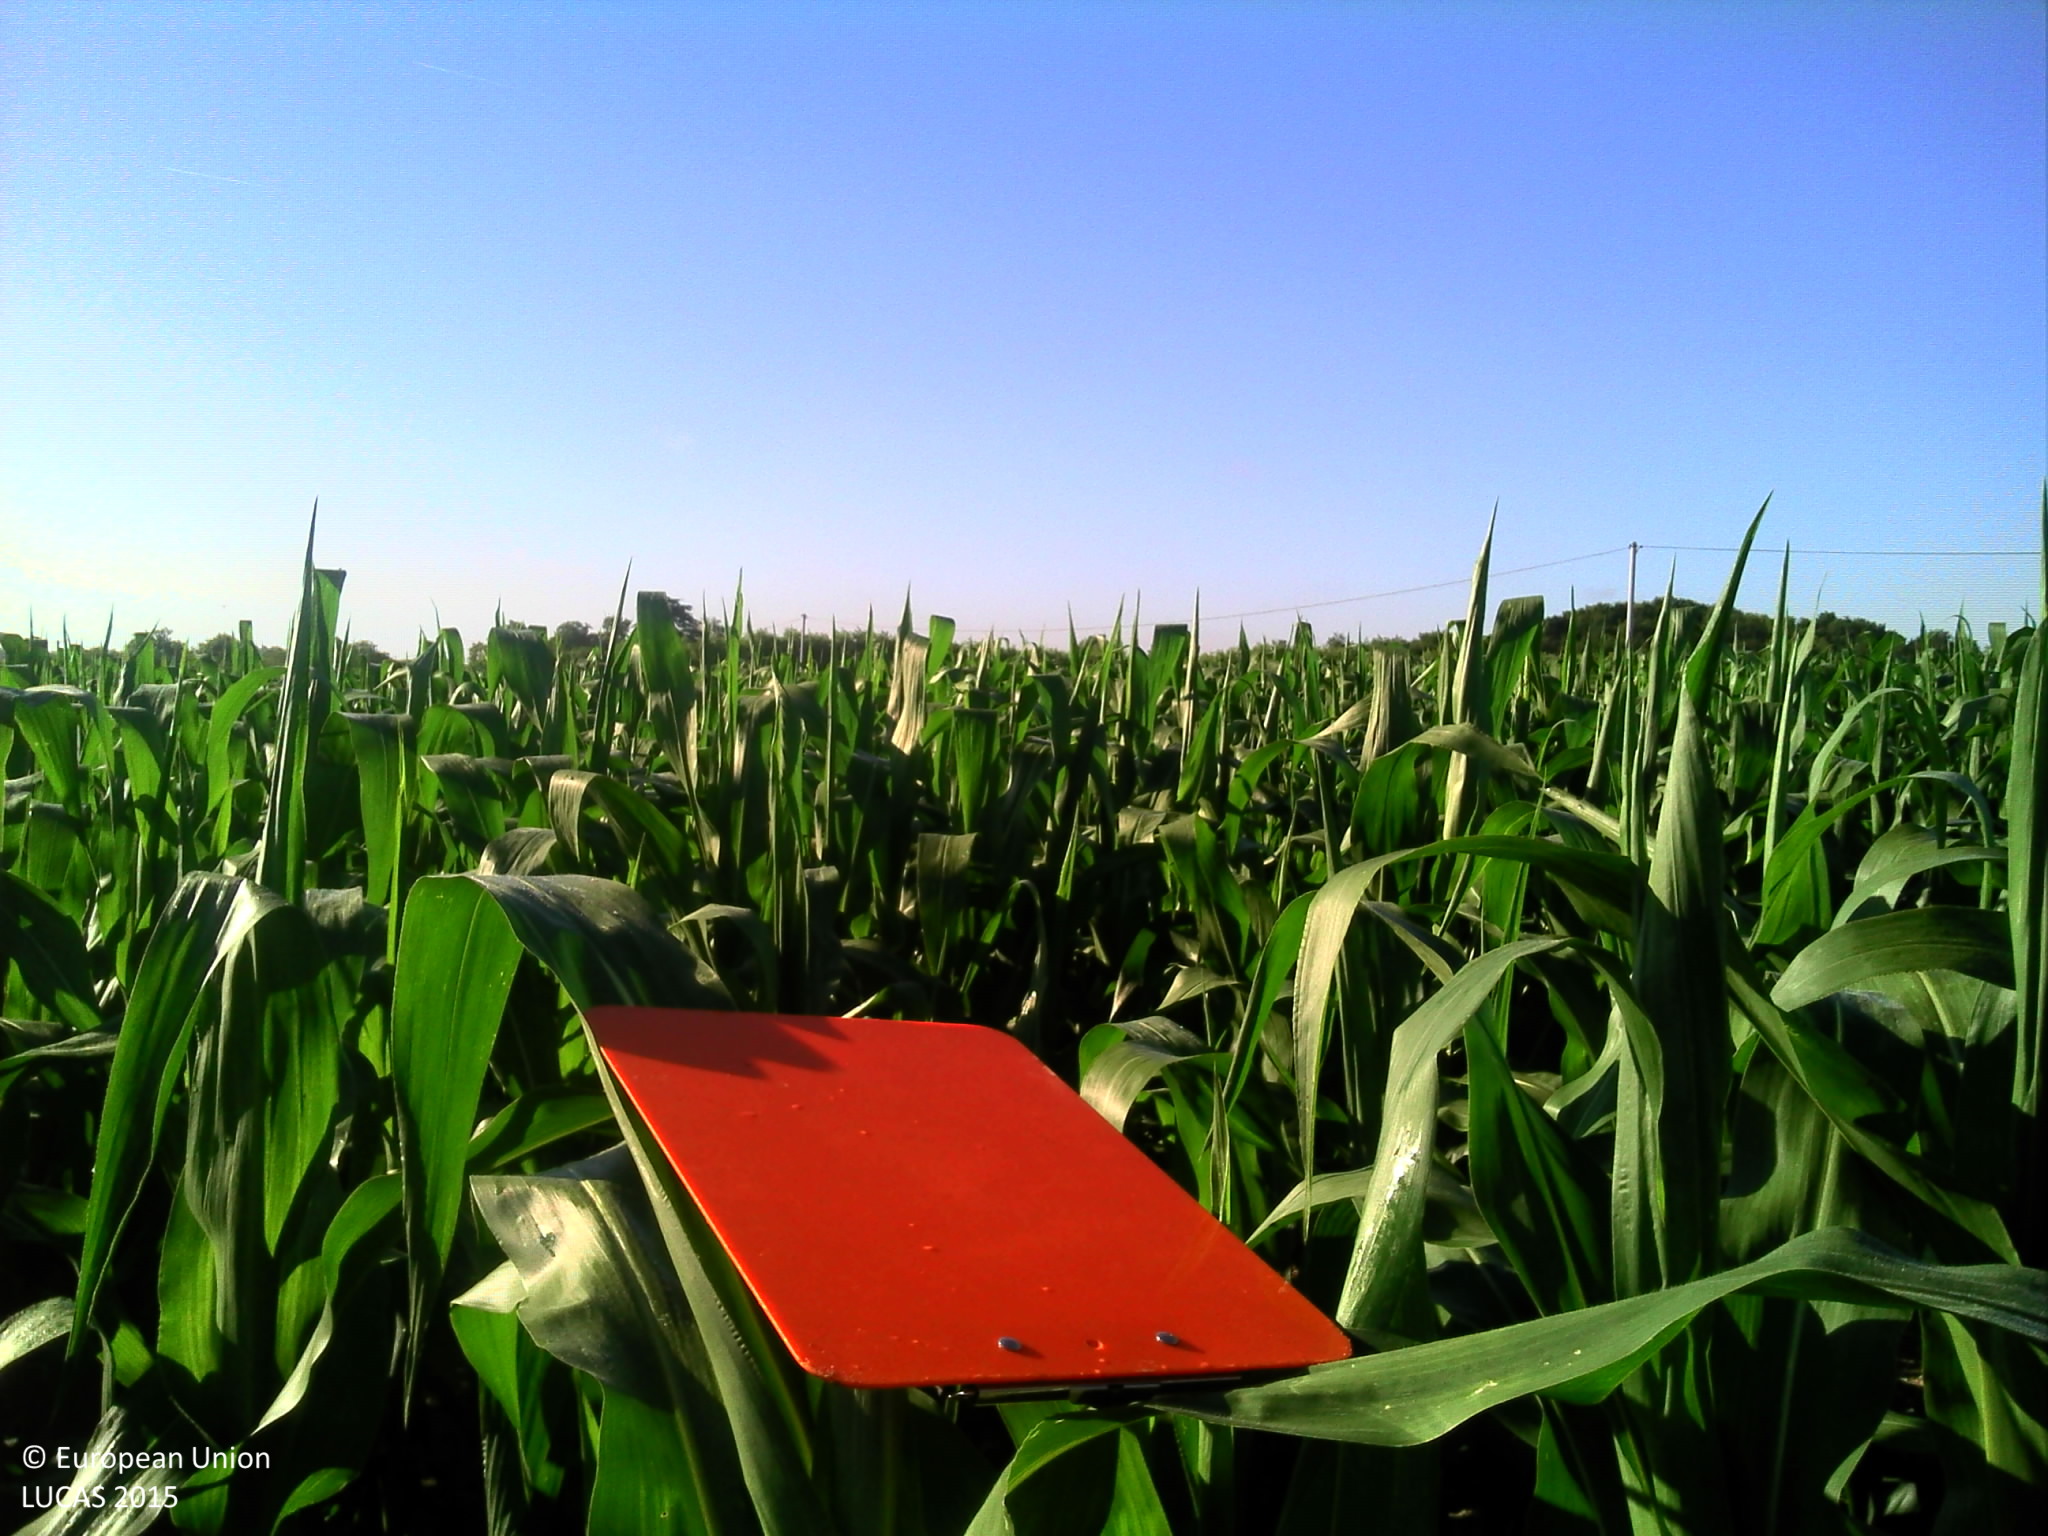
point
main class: Cropland
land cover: Maize
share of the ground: > 75 %
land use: Agriculture (excluding fallow land and kitchen gardens)
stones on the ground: 25 - 50 %
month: June
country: FR
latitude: 45.6325
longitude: -0.8654
